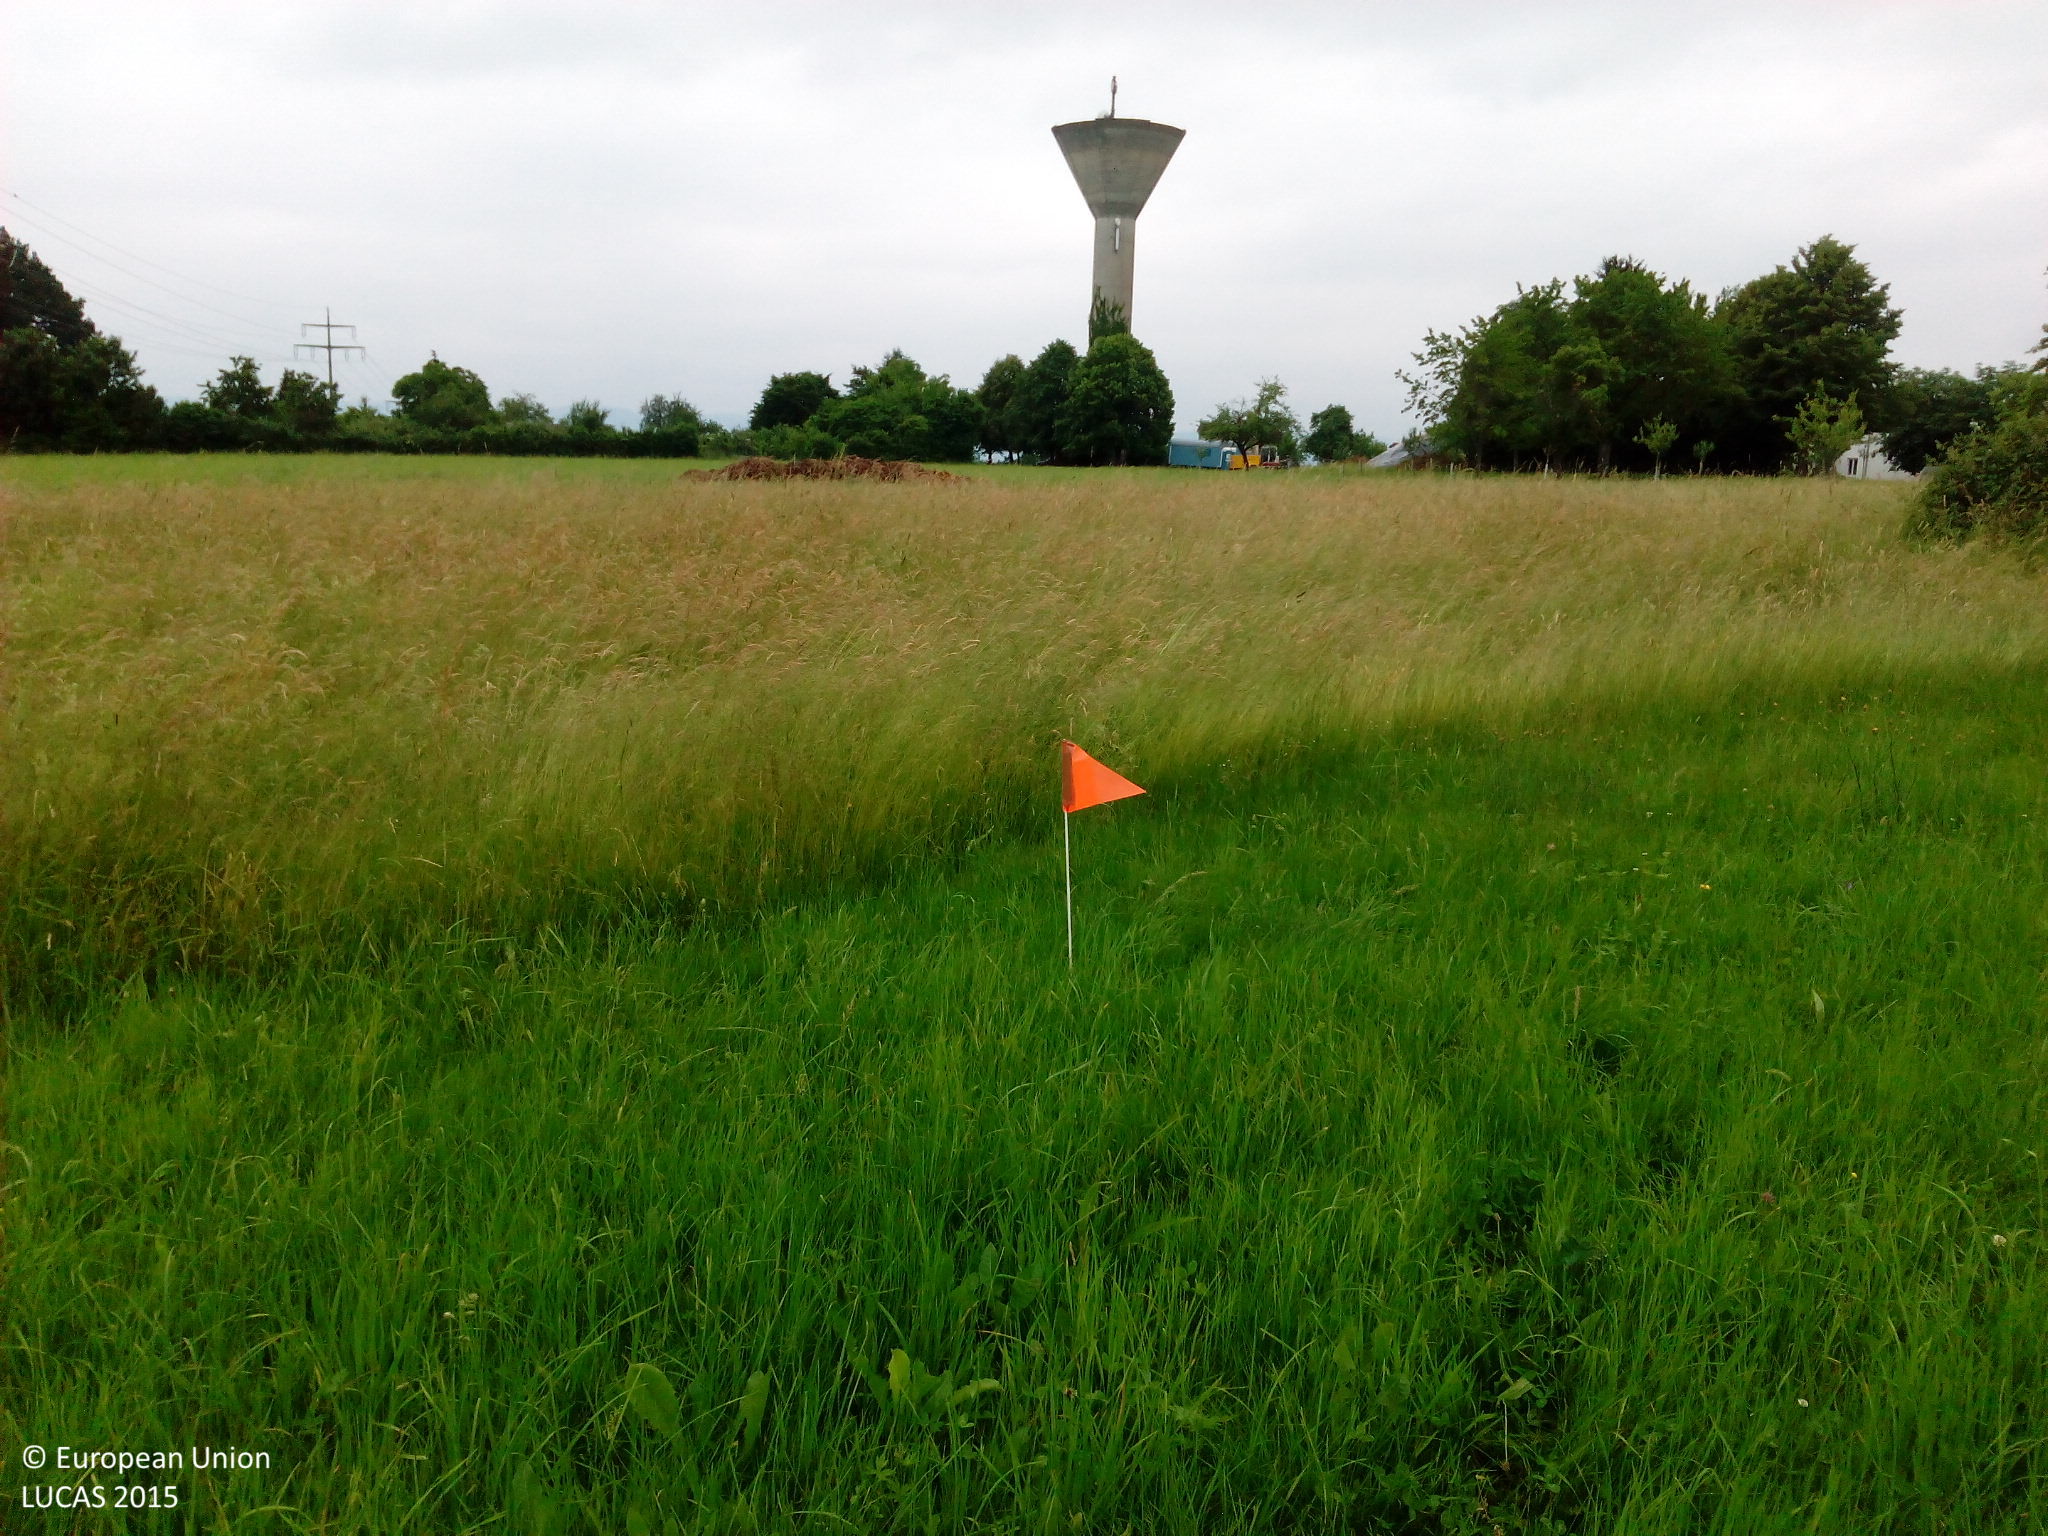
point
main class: Grassland
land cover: Grassland without tree/shrub cover
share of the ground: > 75 %
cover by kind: herbaceous plants 100 %
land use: Agriculture (excluding fallow land and kitchen gardens)
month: June
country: DE
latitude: 48.7627
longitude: 9.6329
